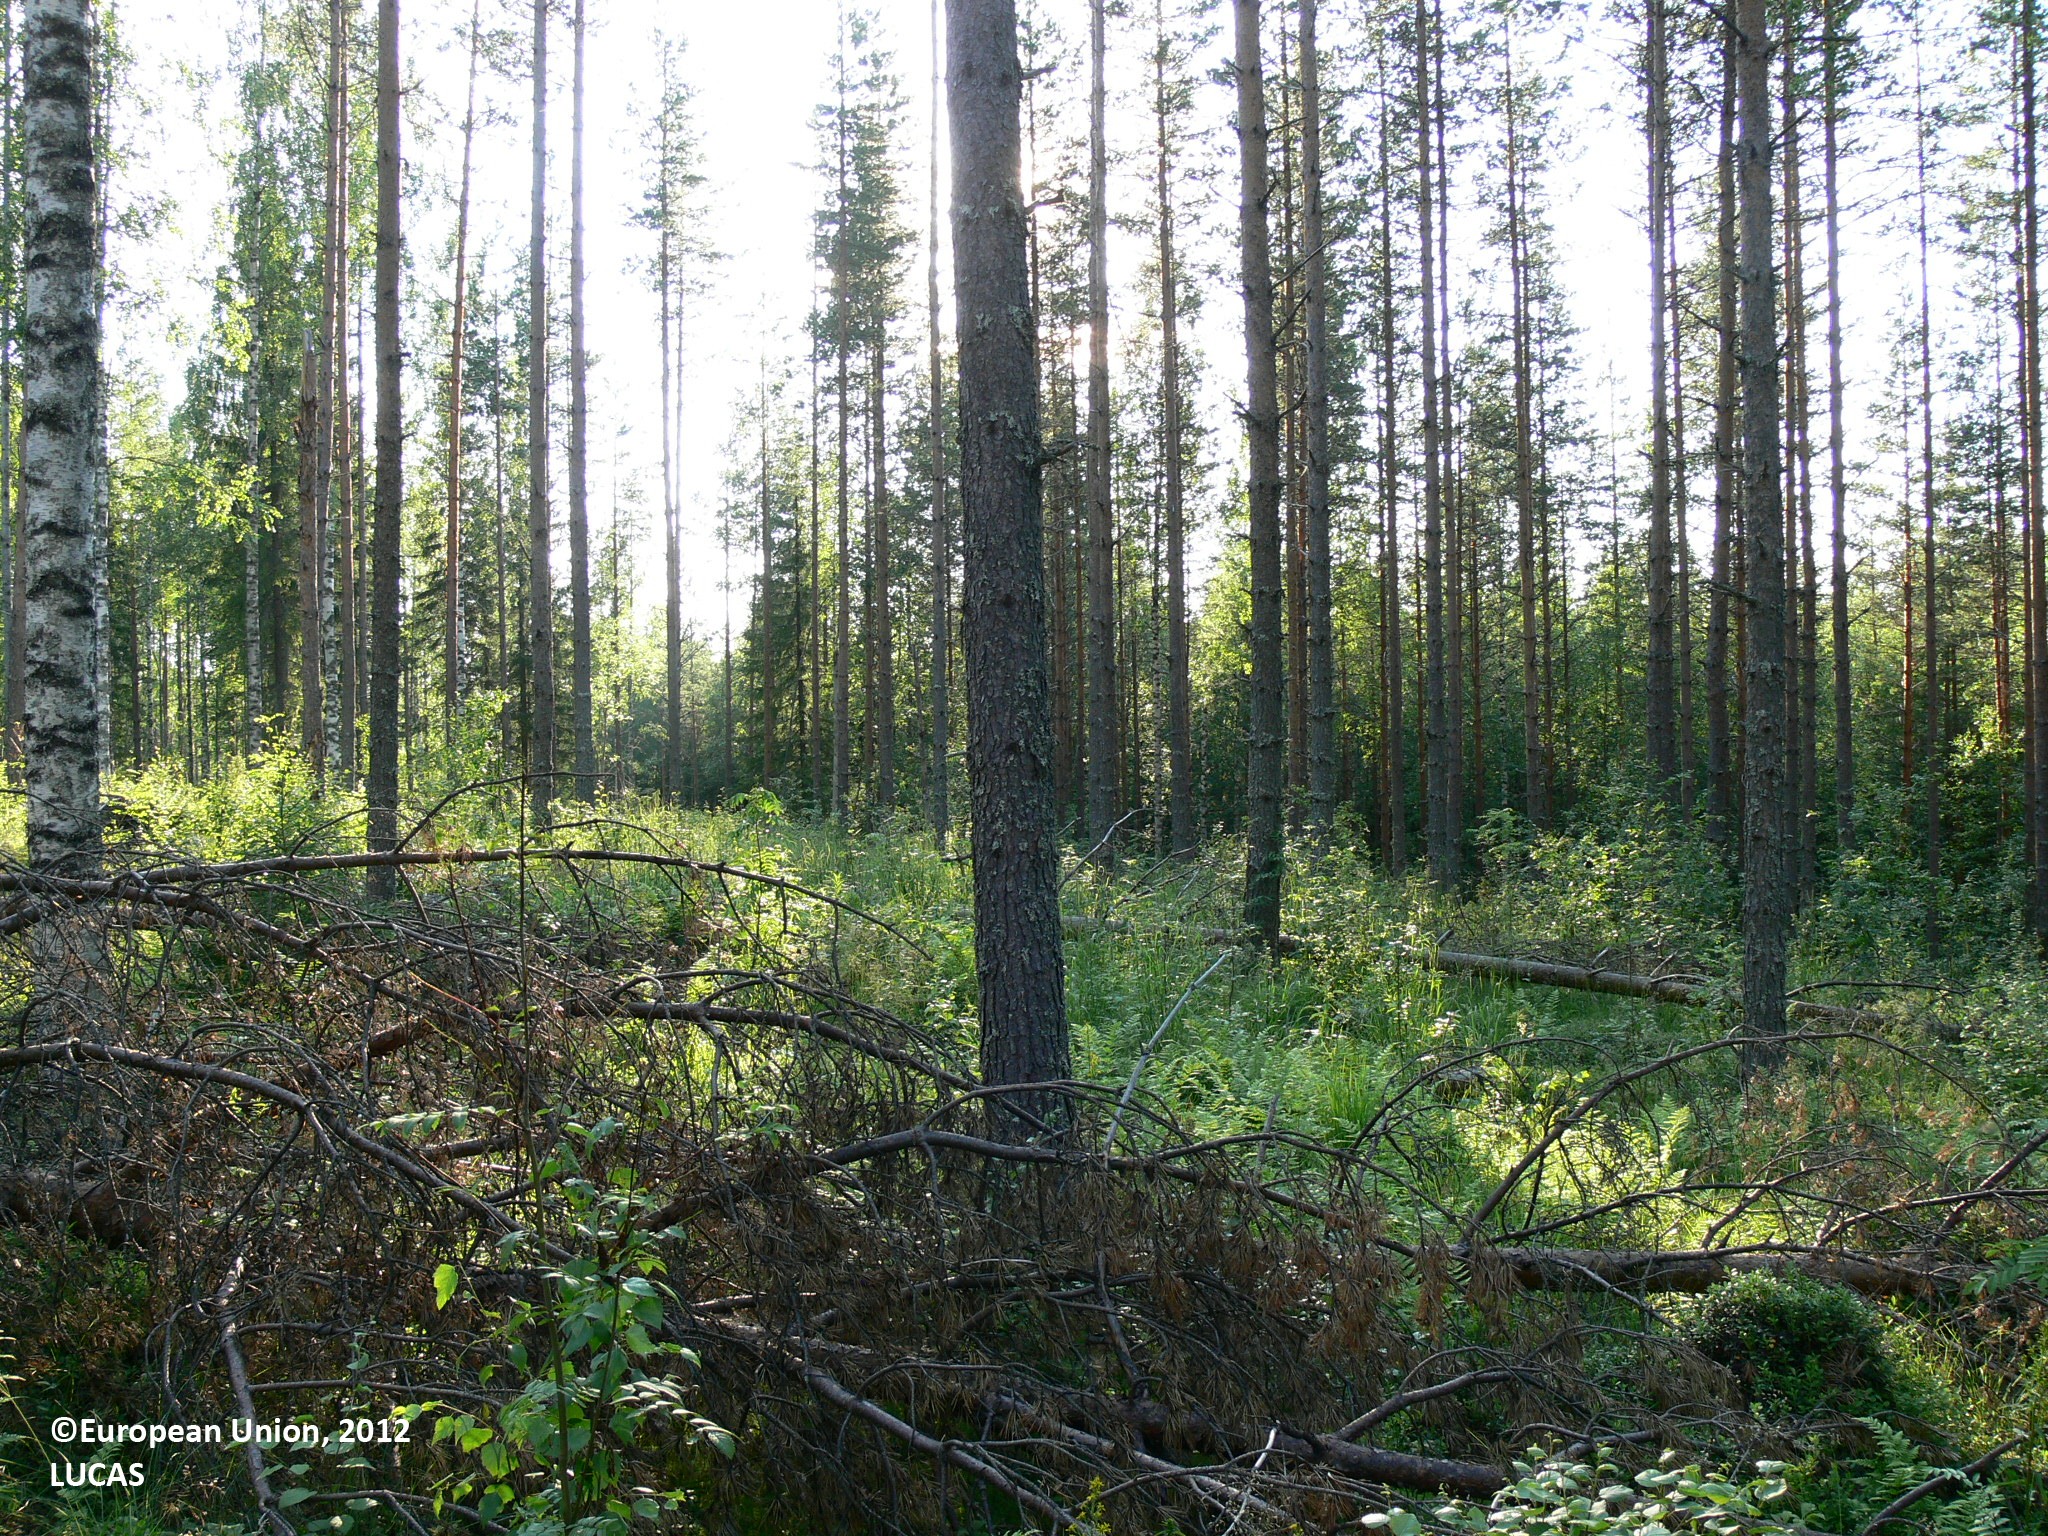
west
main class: Woodland
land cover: Pine dominated mixed woodland
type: boreal forest
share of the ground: > 75 %
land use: Forestry
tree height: > 5 m
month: July
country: FI
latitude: 63.2985
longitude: 30.8965
